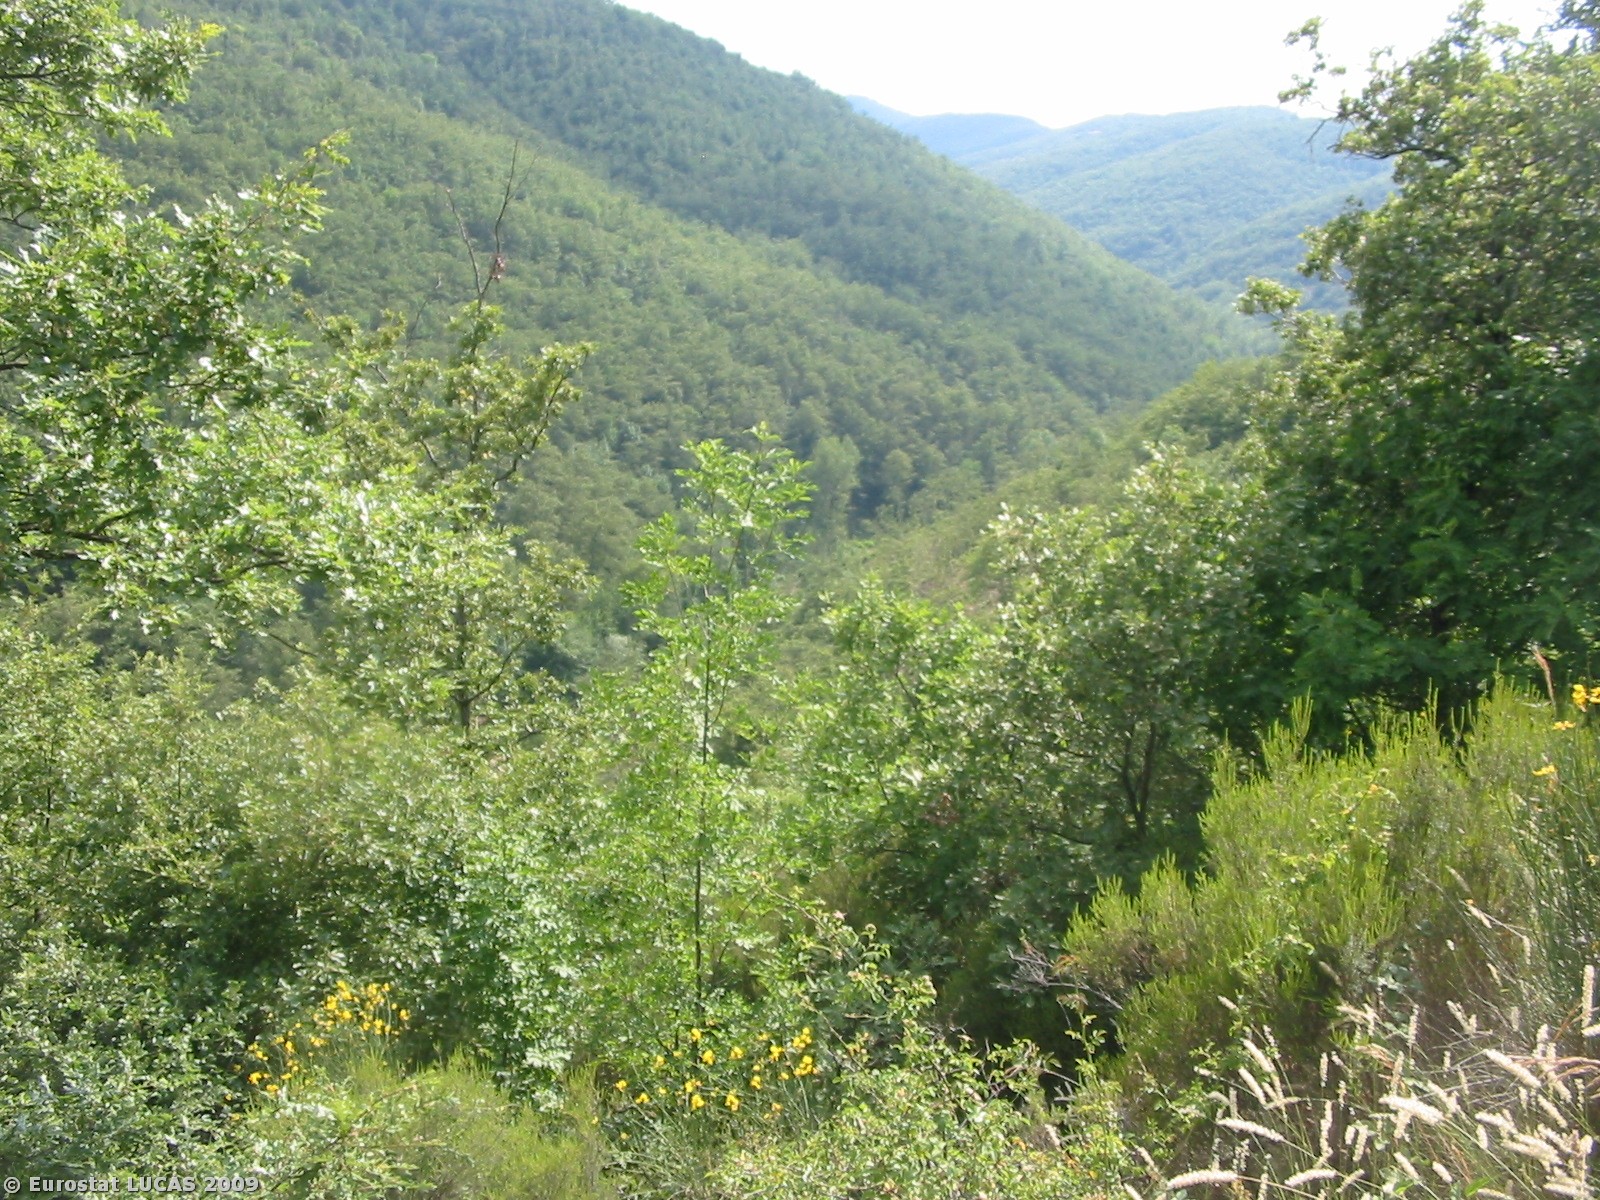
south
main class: Woodland
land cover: Broadleaved woodland
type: broadleaved evergreen forest
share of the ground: > 75 %
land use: Forestry
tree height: > 5 m
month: June
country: IT
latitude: 43.3385
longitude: 12.0049
